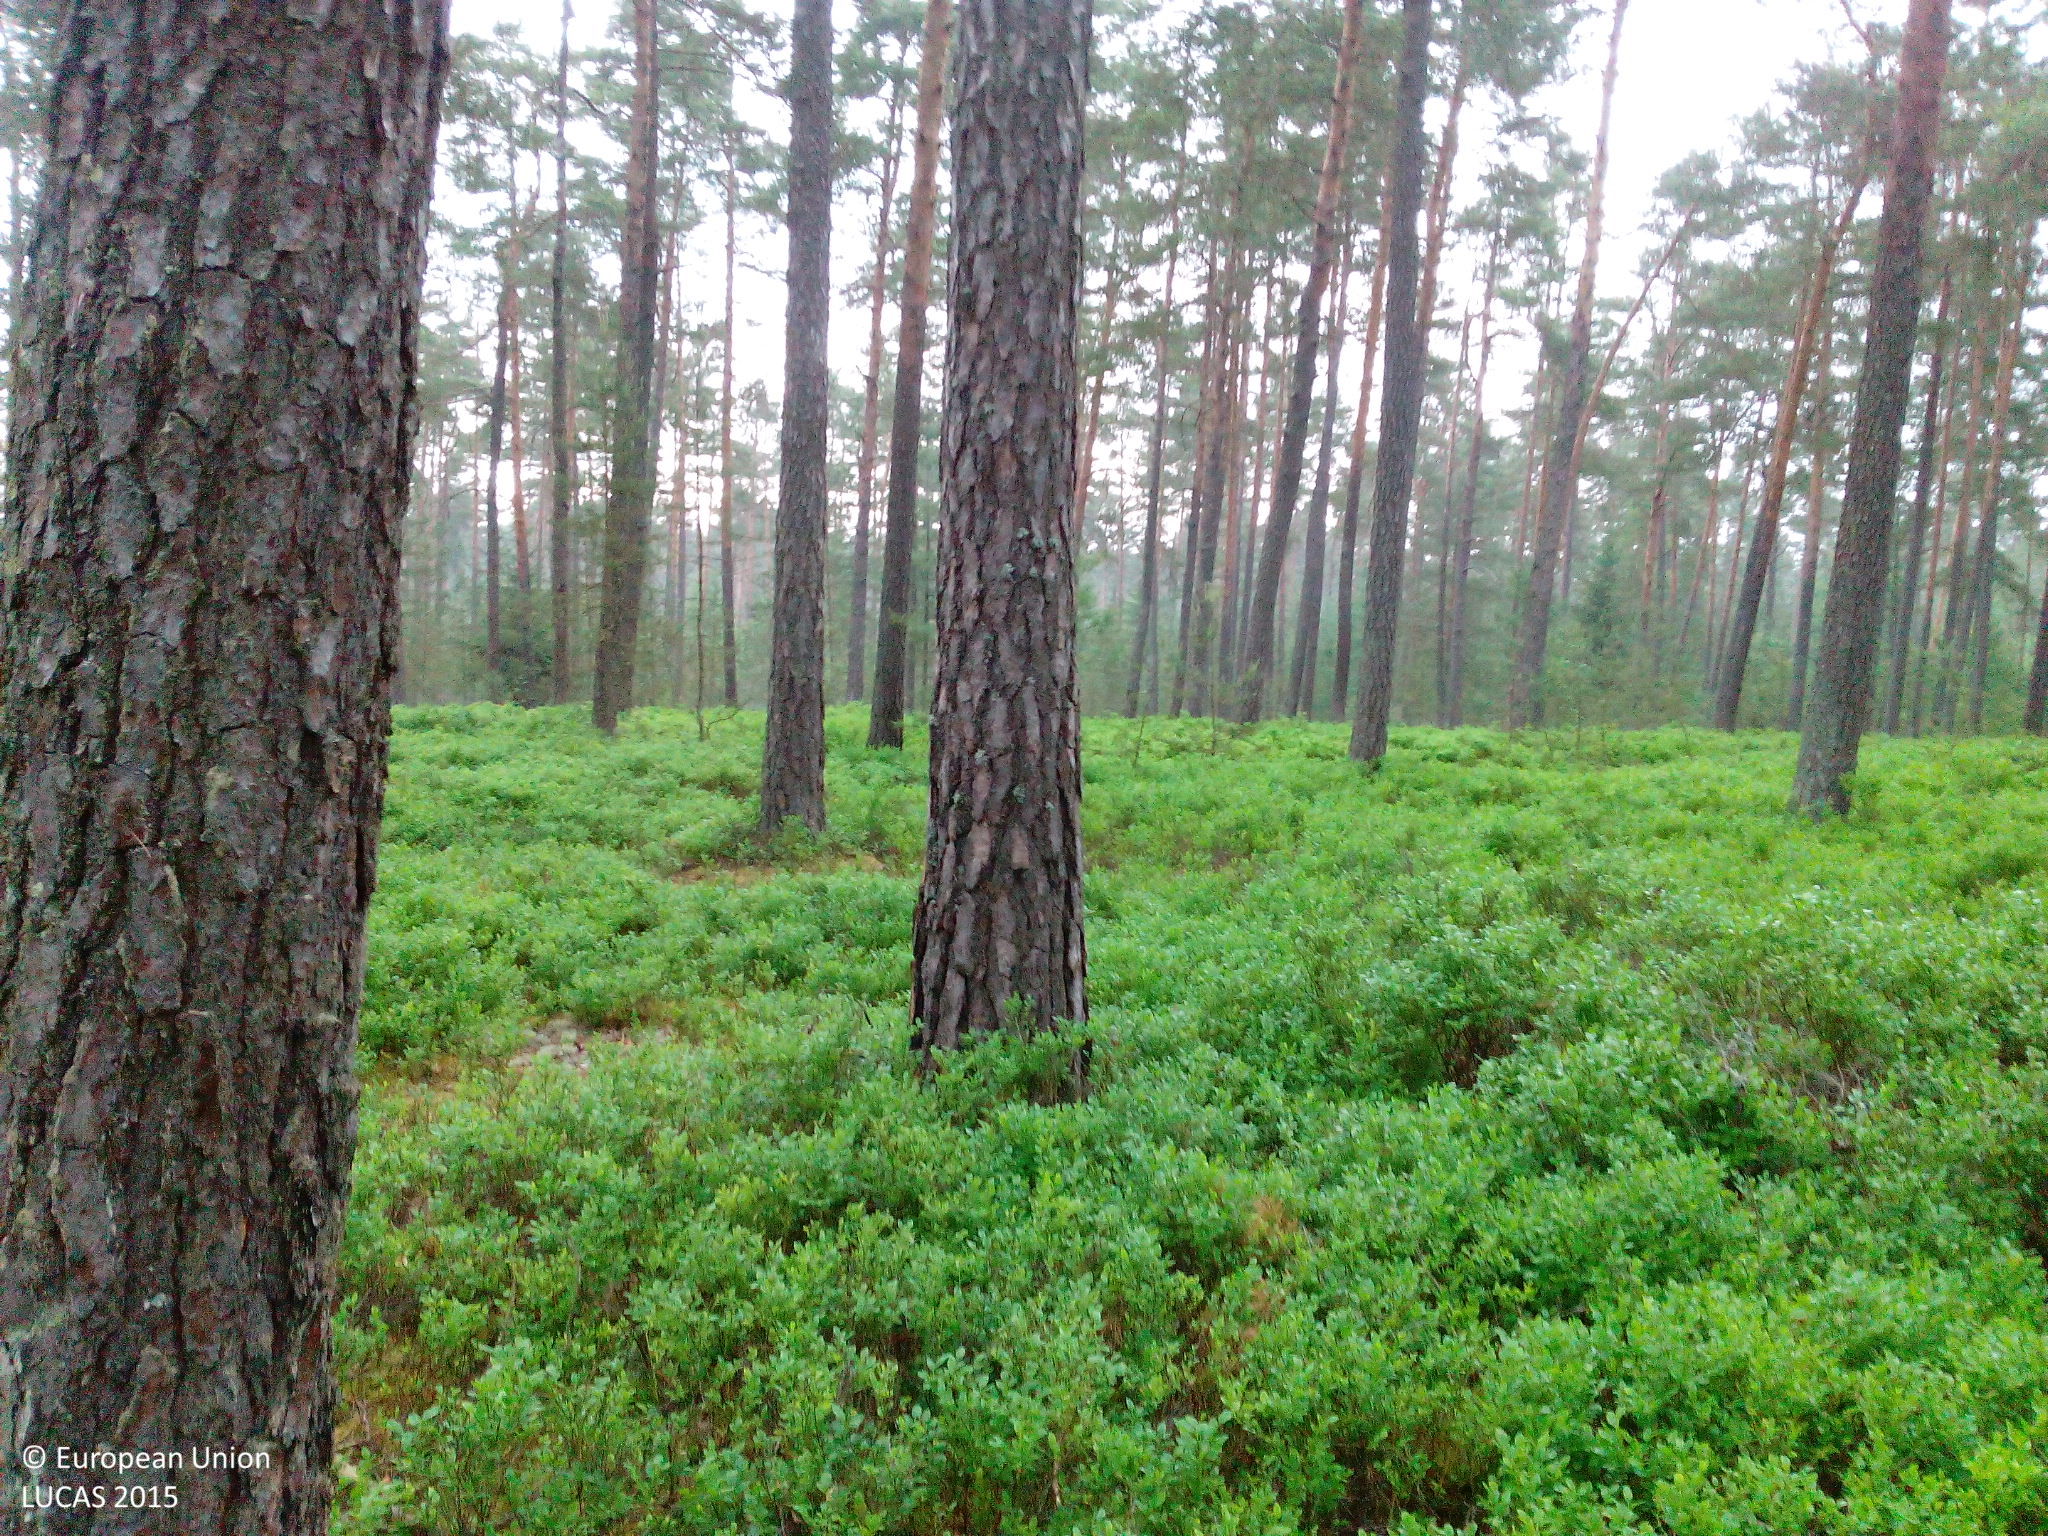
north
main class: Woodland
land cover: Pine dominated coniferous woodland
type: hemiboreal forest and nemoral coniferous forest and mixed broadleaved-coniferous forest
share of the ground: 50 - 75 %
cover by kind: coniferous forest trees 70 %, shrubs 20 %, herbaceous plants 10 %
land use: Forestry
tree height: > 5 m
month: June
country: DE
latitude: 49.2599
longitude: 12.3766
